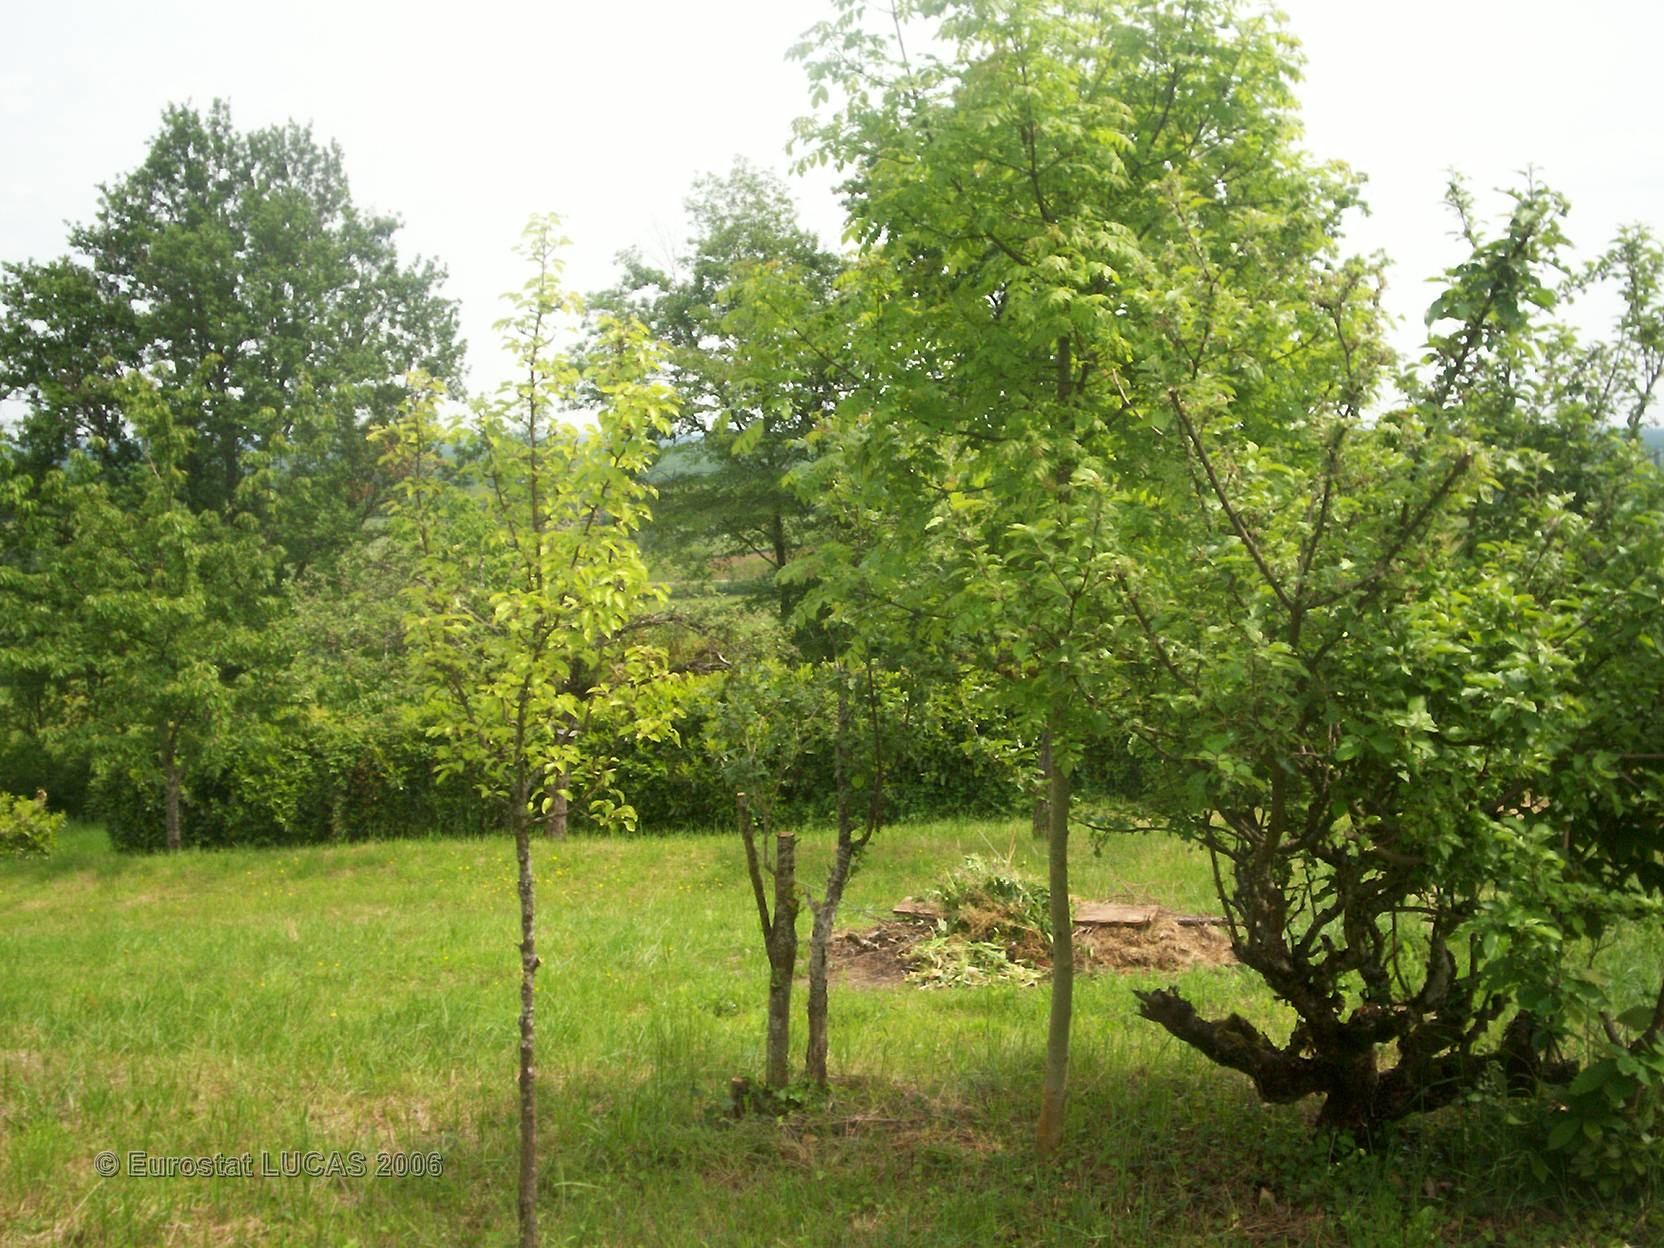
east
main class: Cropland
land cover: Apple fruit
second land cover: Grassland with sparse tree/shrub cover
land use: Kitchen garden
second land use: Residential
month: May
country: FR
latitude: 46.7253
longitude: 4.7020
